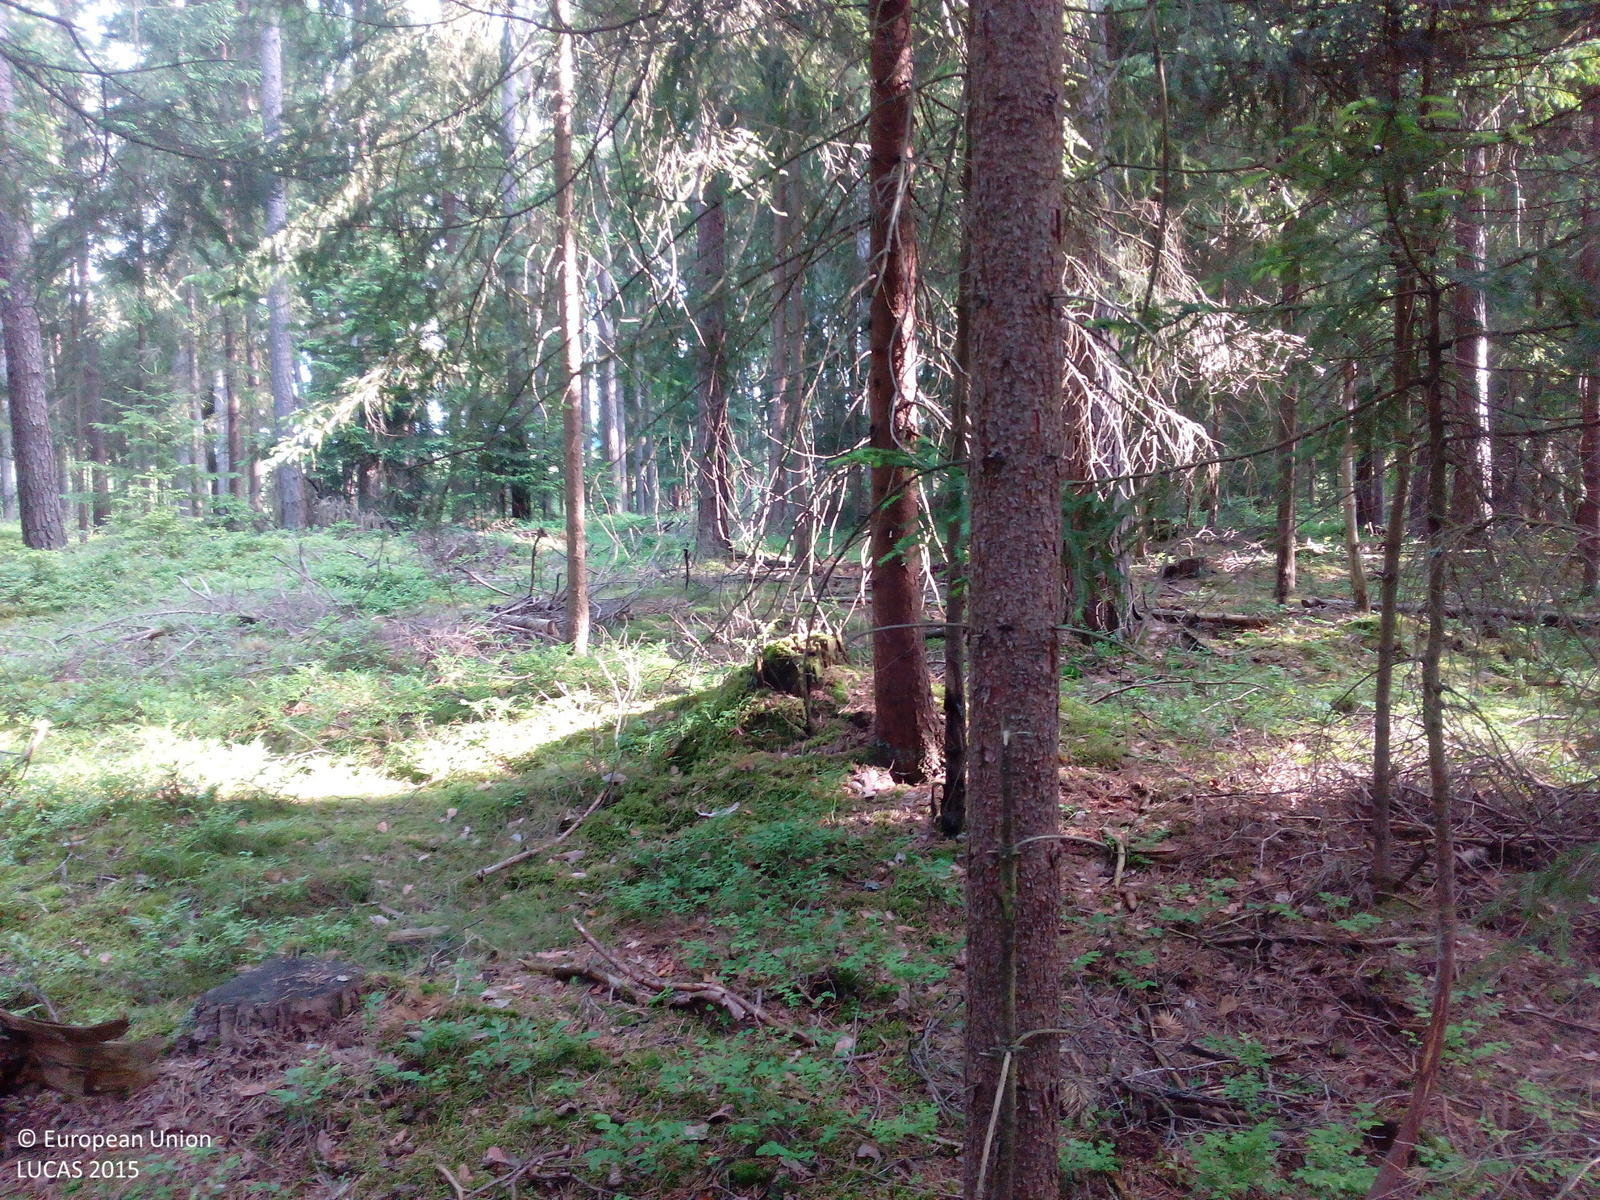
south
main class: Woodland
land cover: Spruce dominated coniferous woodland
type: hemiboreal forest and nemoral coniferous forest and mixed broadleaved-coniferous forest
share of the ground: > 75 %
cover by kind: coniferous forest trees 75 %, shrubs 10 %, lichens and mosses 10 %, unconsolidated bare surface 5 %
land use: Forestry
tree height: > 5 m
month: June
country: DE
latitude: 49.9828
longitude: 12.2170
